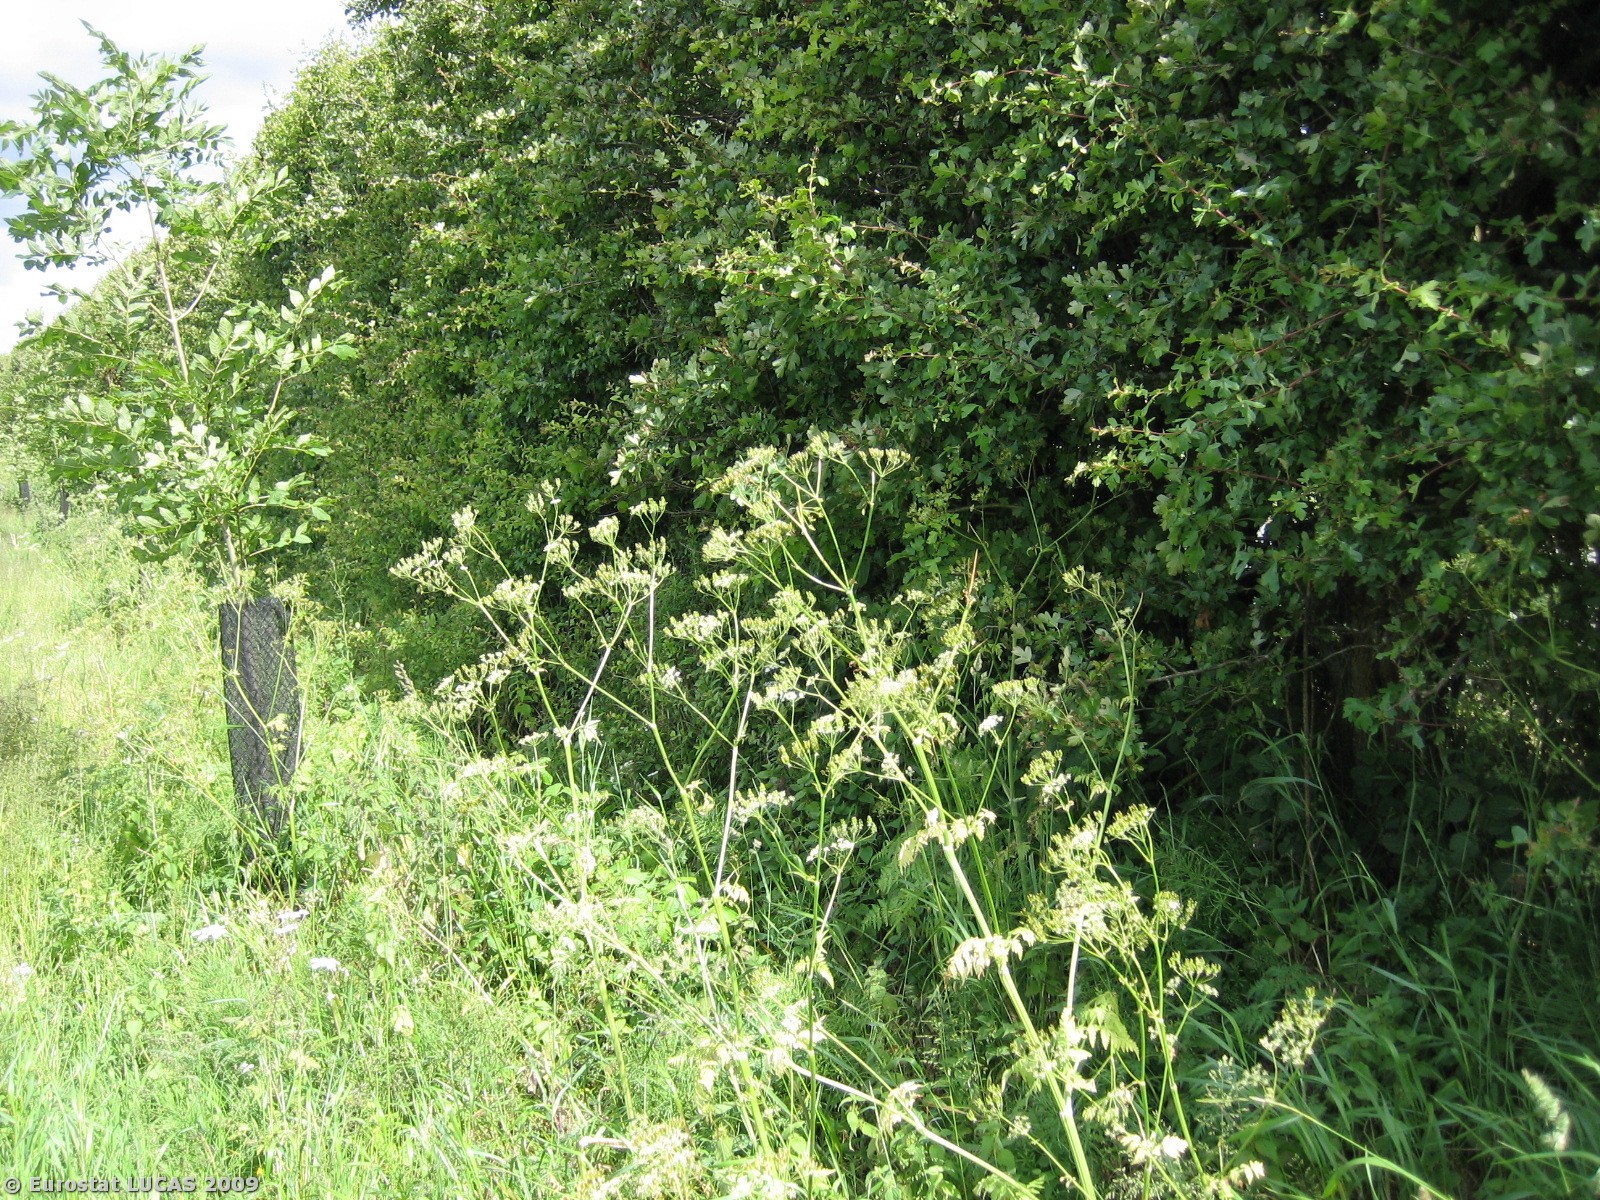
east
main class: Cropland
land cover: Common wheat
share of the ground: > 75 %
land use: Agriculture (excluding fallow land and kitchen gardens)
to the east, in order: Common wheat; Lines of trees; Managed hedges; Paved roads, cycling and walking lanes; Grass margins; Fences; Temporary grasslands
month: June
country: DK
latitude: 55.5942
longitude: 9.6988
